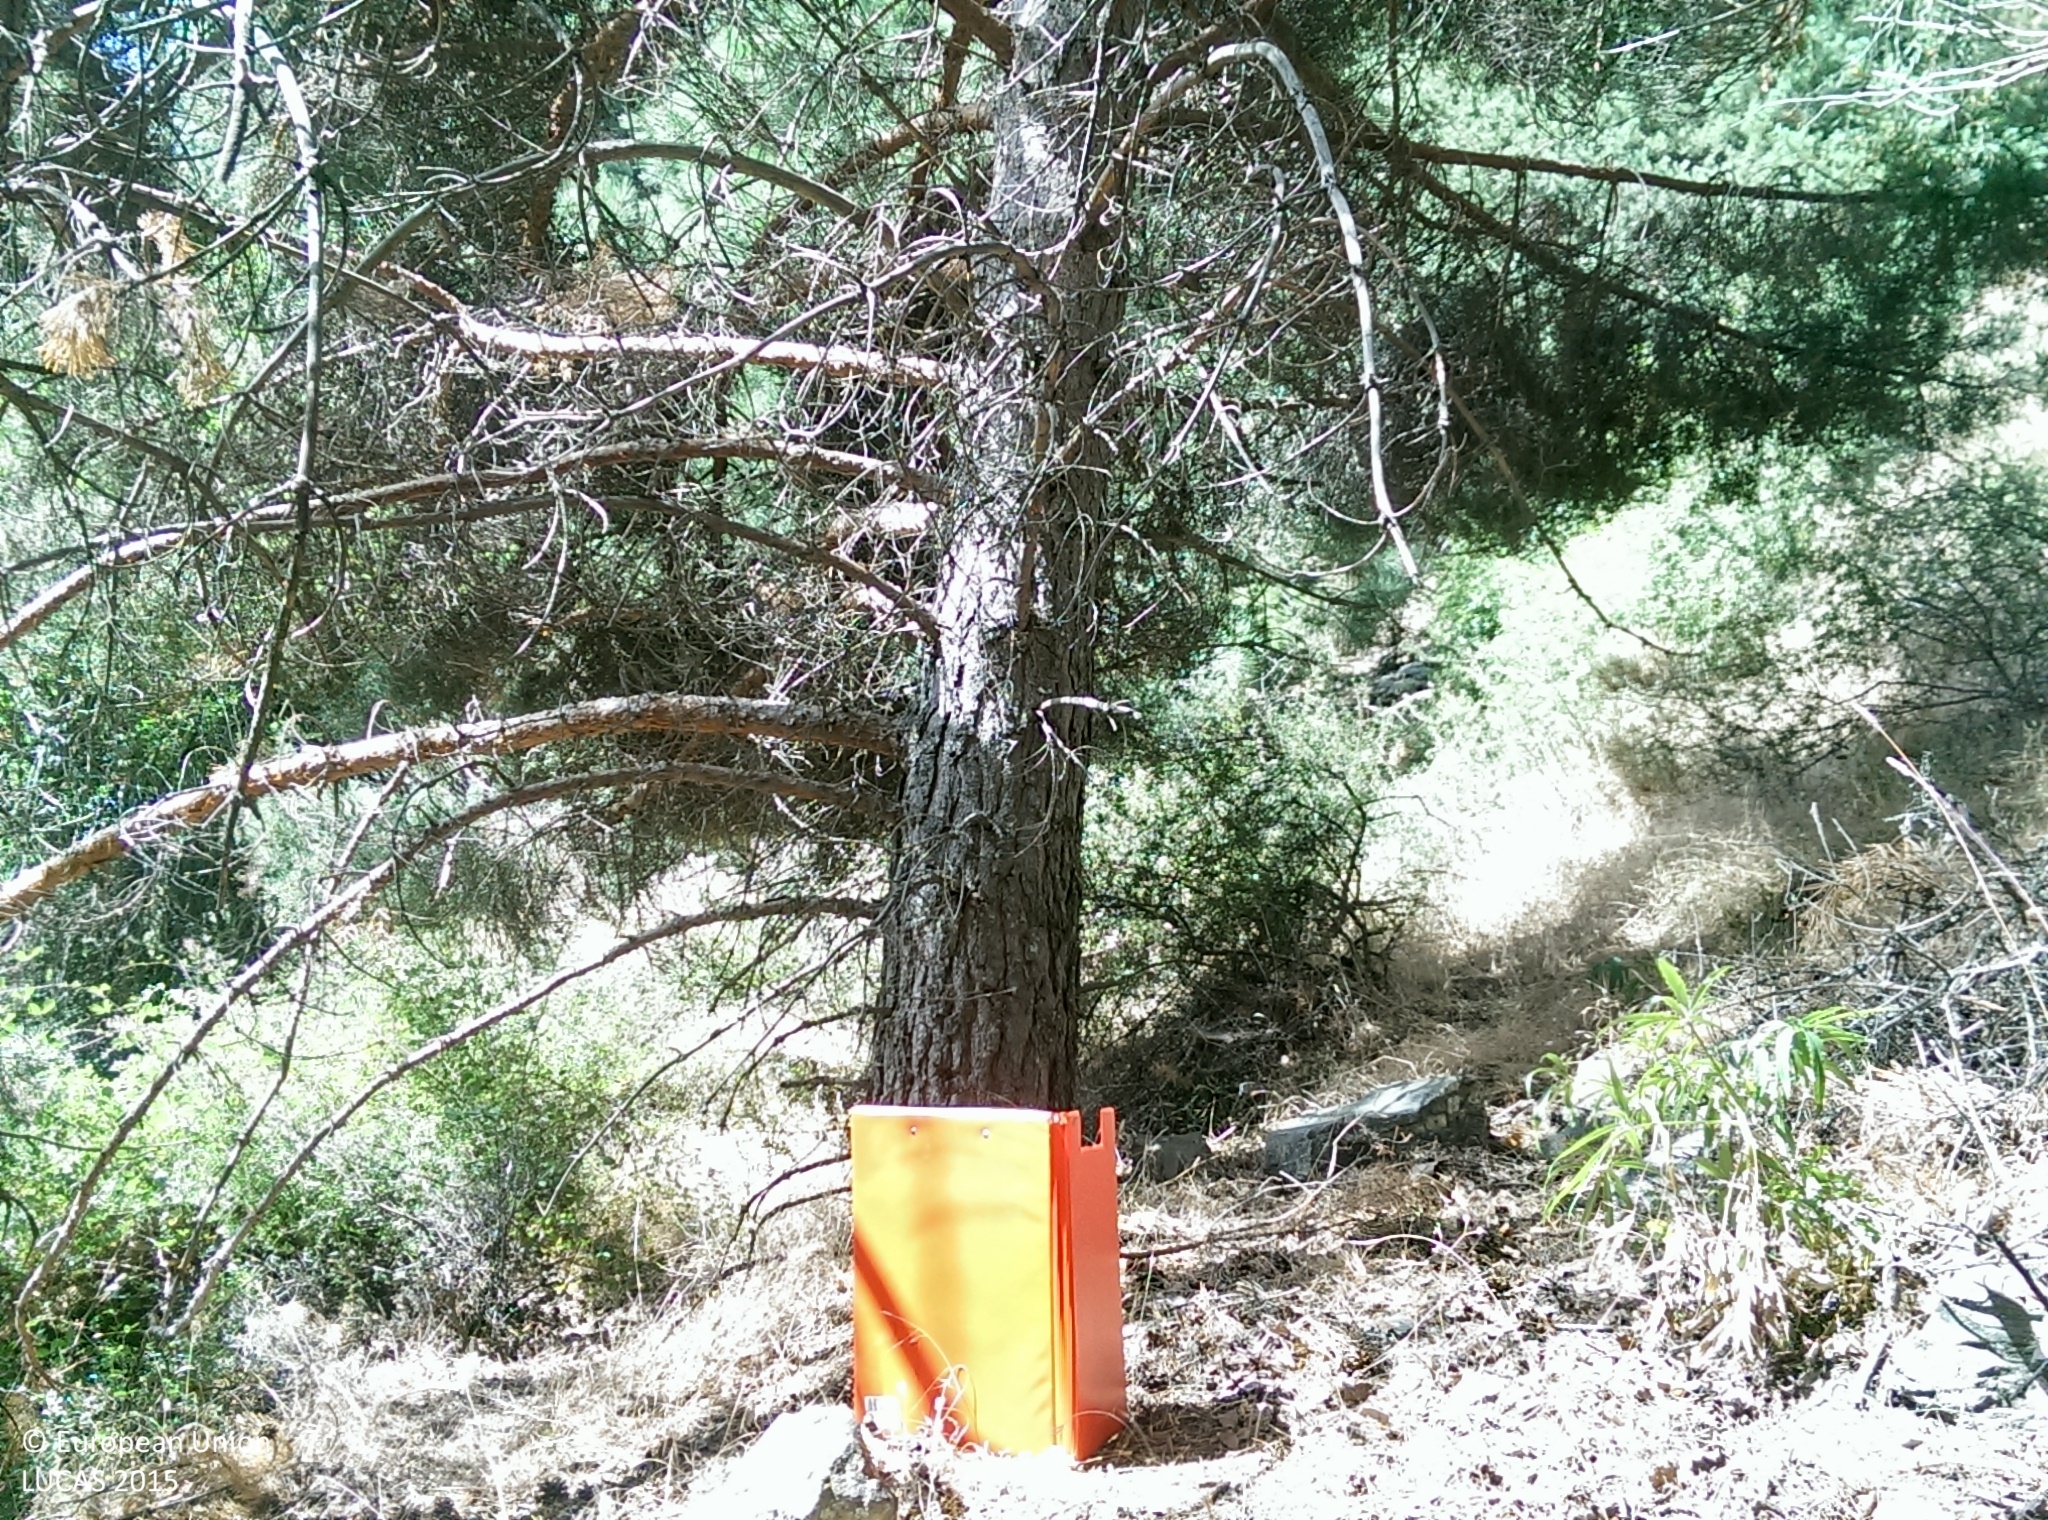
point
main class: Woodland
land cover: Pine dominated coniferous woodland
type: coniferous forest of the mediterranean region
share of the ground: > 75 %
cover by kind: coniferous forest trees 70 %, broadleaved forest trees 10 %, shrubs 10 %, herbaceous plants 5 %, unconsolidated bare surface 5 %
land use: Forestry
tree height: > 5 m
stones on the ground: 25 - 50 %
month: July
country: ES
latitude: 37.1512
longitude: -3.2151
